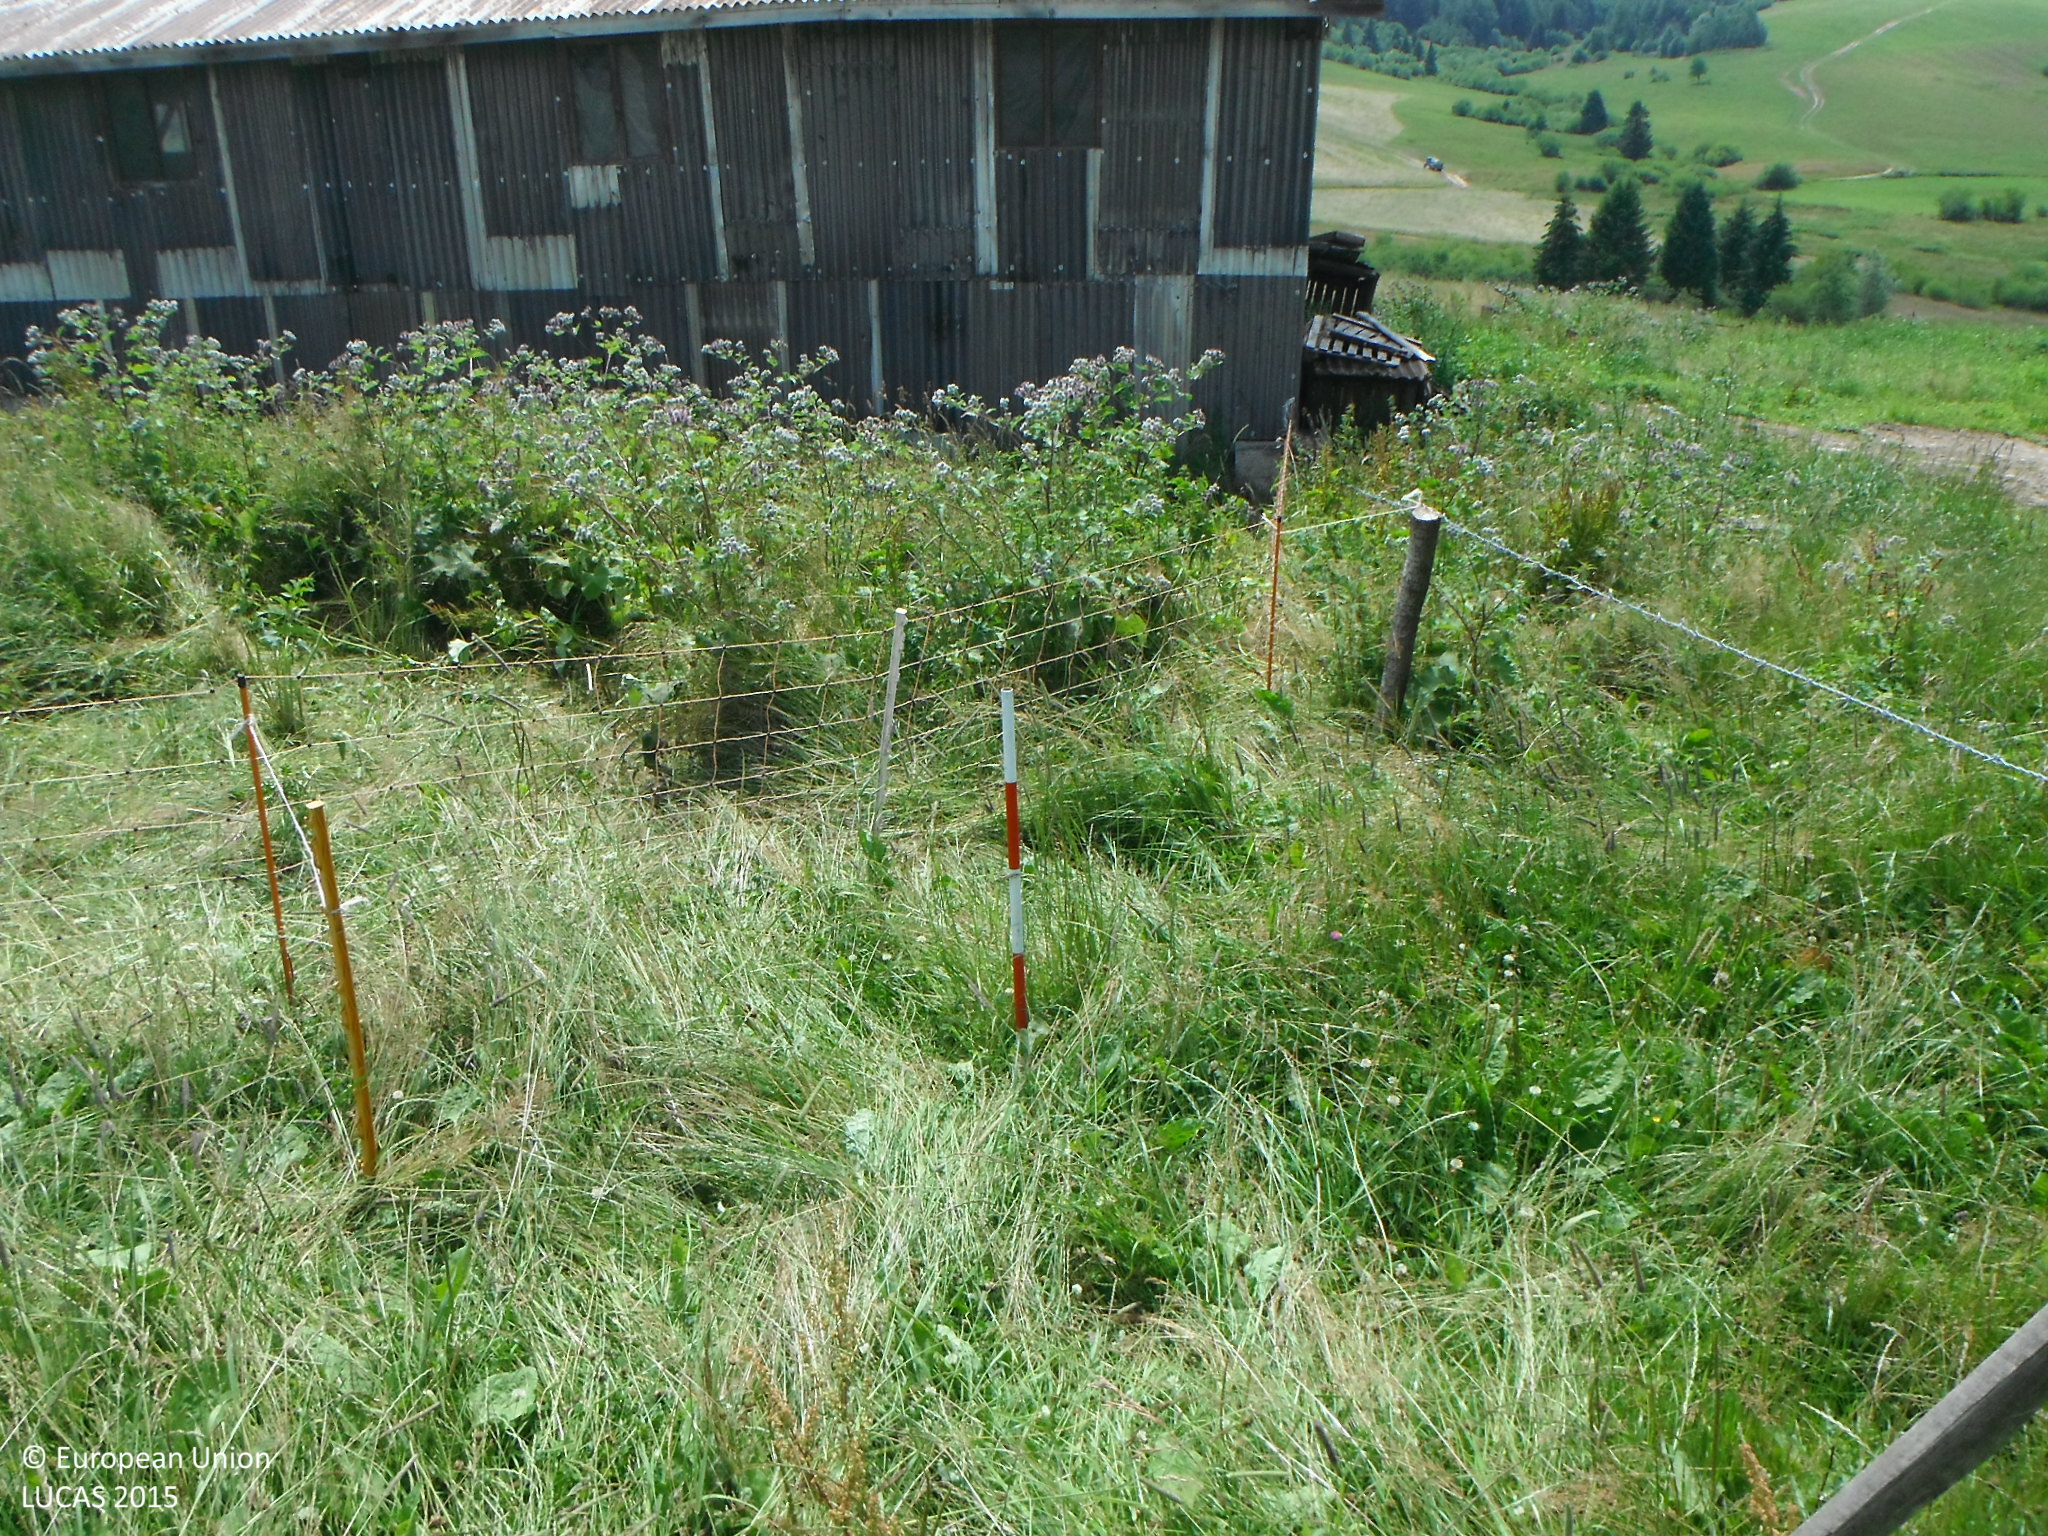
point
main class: Grassland
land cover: Grassland without tree/shrub cover
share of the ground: > 75 %
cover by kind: herbaceous plants 100 %
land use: Agriculture (excluding fallow land and kitchen gardens)
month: July
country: SK
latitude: 49.3656
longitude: 19.7645
